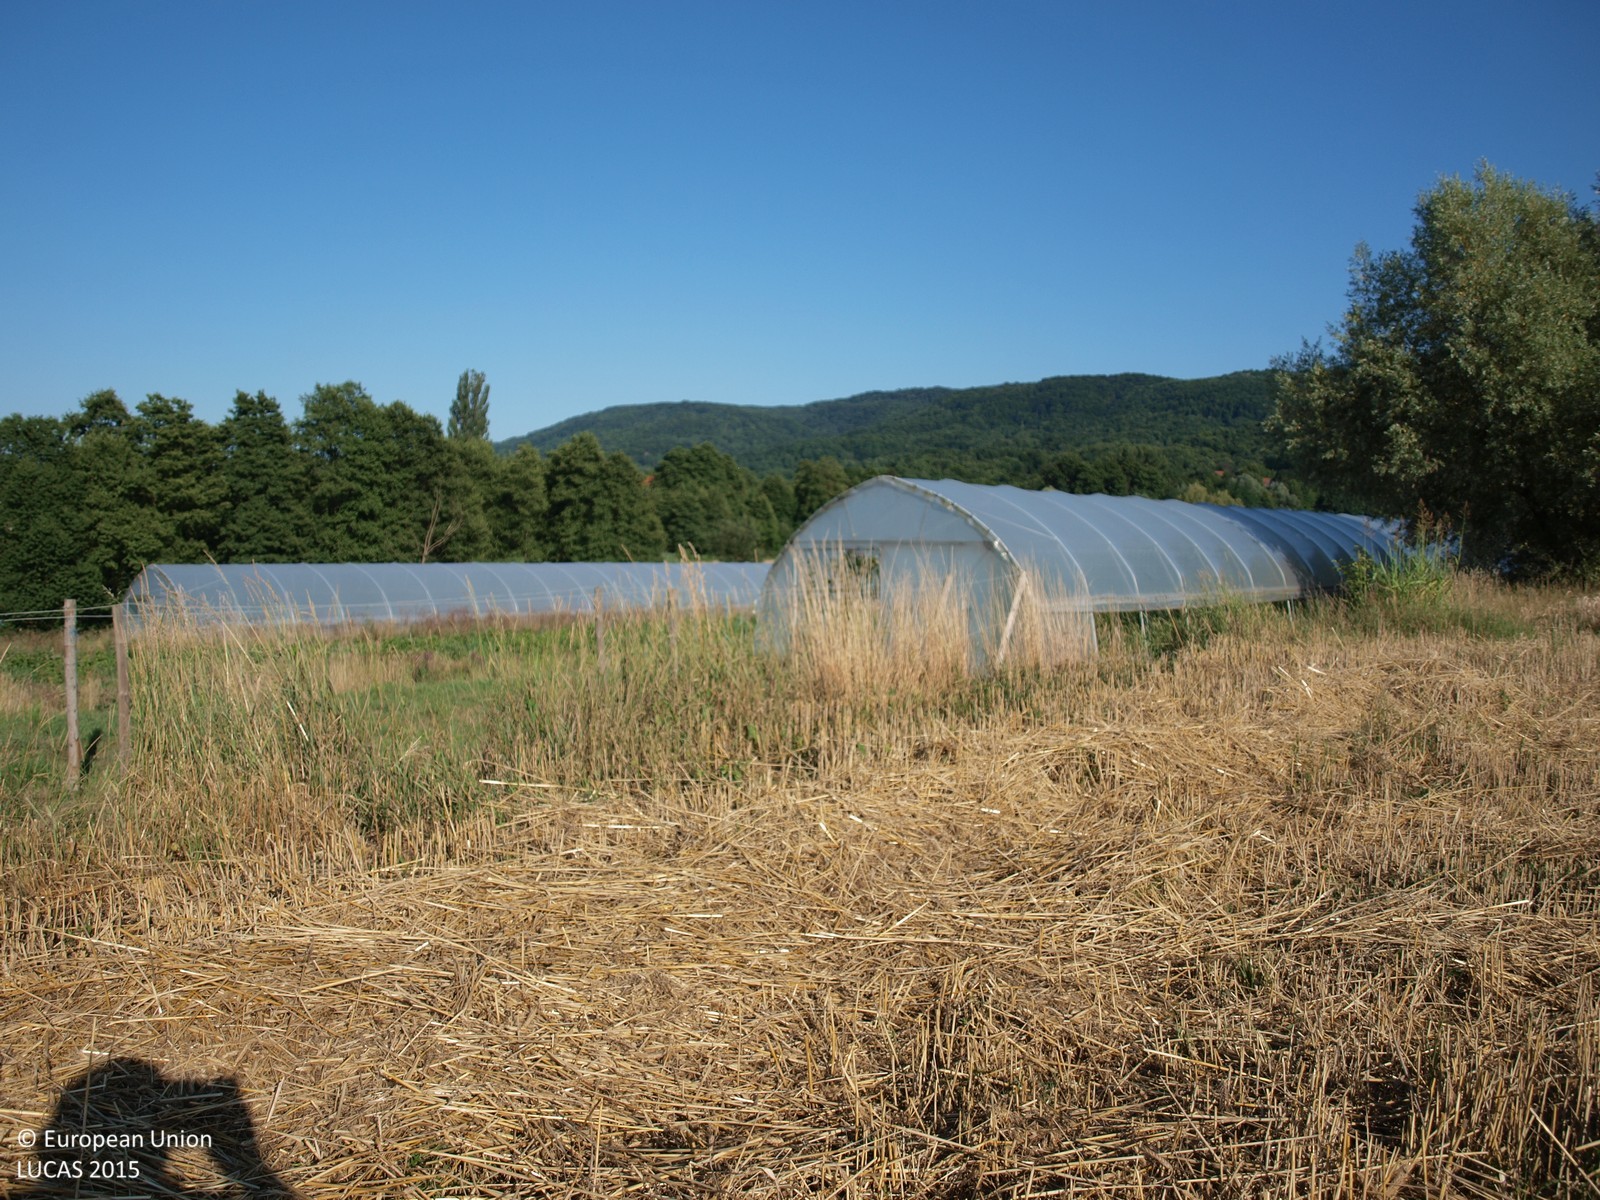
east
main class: Cropland
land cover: Barley
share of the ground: > 75 %
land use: Agriculture (excluding fallow land and kitchen gardens)
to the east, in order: Barley; Grass margins; Dry pulses; Strawberries; Potatoes; Grassland without tree/shrub cover; Grassland with sparse tree/shrub cover; Rivers and streams; Grassland with sparse tree/shrub cover; Grassland without tree/shrub cover; Electric lines; Broadleaved woodland; Rivers and streams; Electric lines; Grassland without tree/shrub cover; Maize
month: July
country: HR
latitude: 45.9675
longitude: 15.9733
